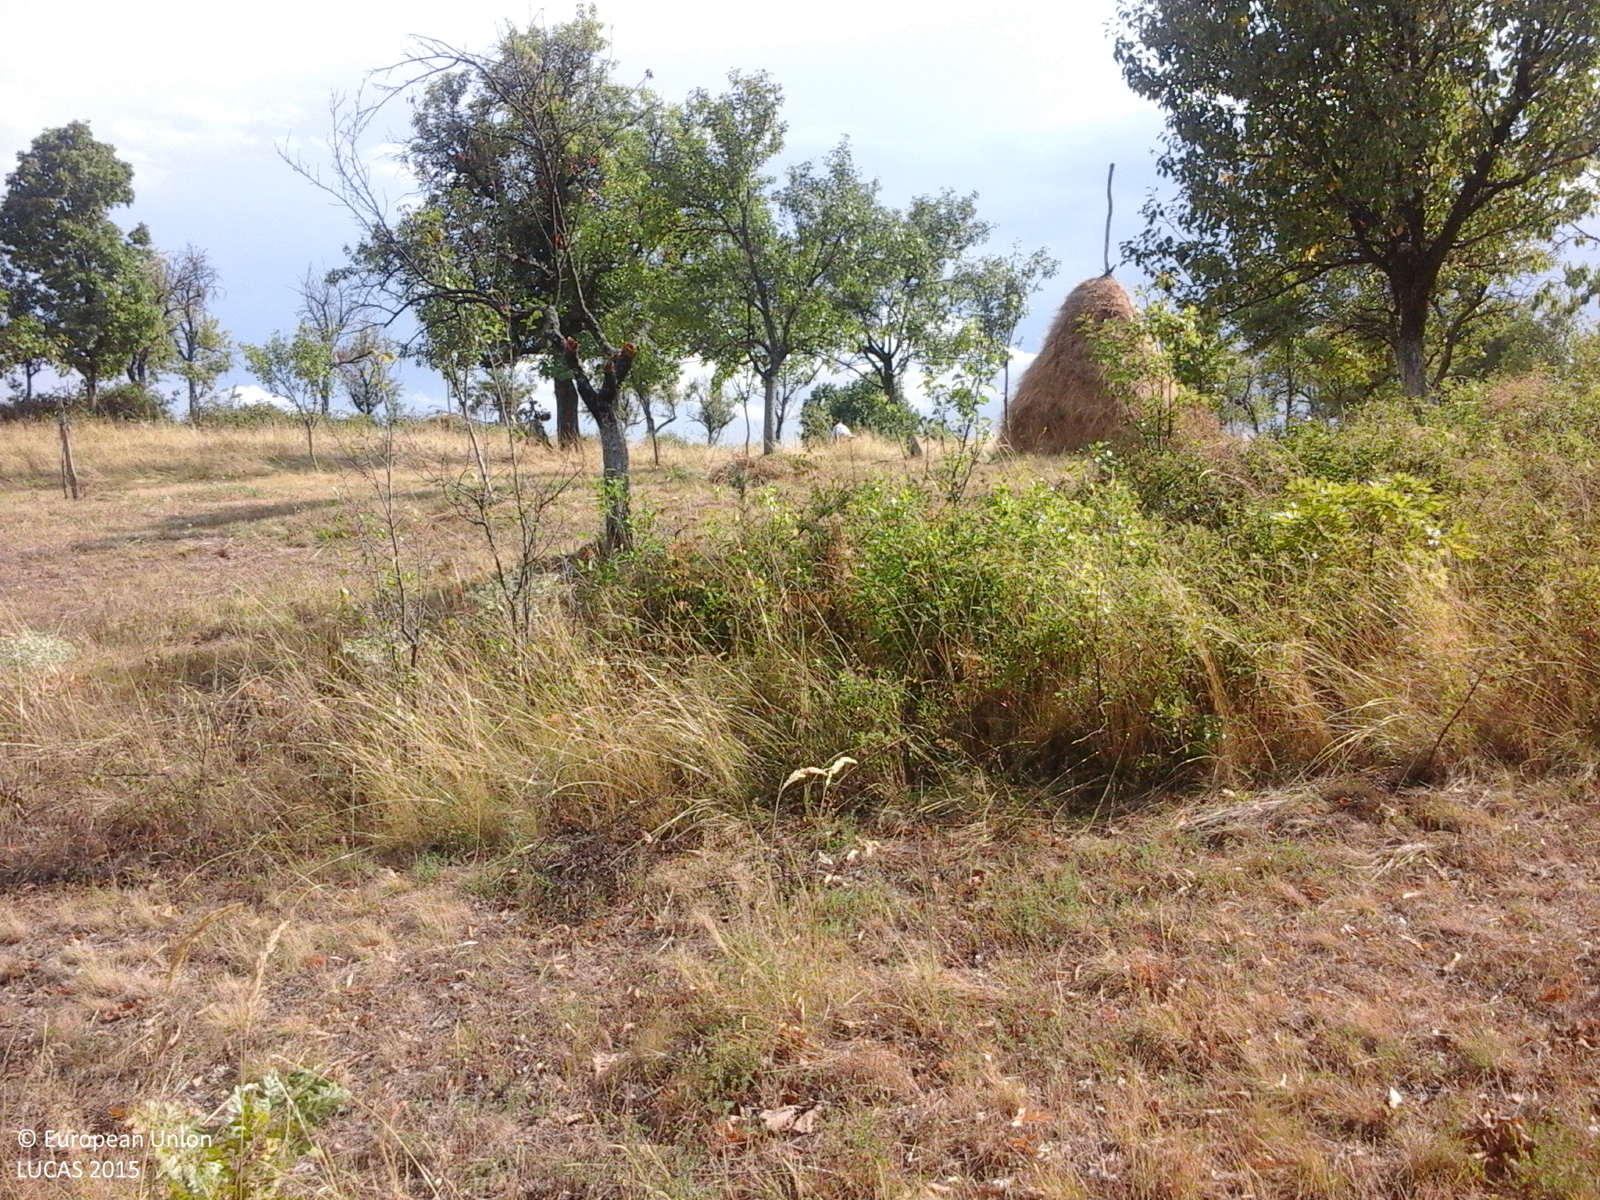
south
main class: Woodland
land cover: Broadleaved woodland
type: acidophilous oak and oak-birch forest
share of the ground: > 75 %
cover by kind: broadleaved forest trees 100 %
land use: Forestry
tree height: > 5 m
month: August
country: RO
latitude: 44.7632
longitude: 22.4589
